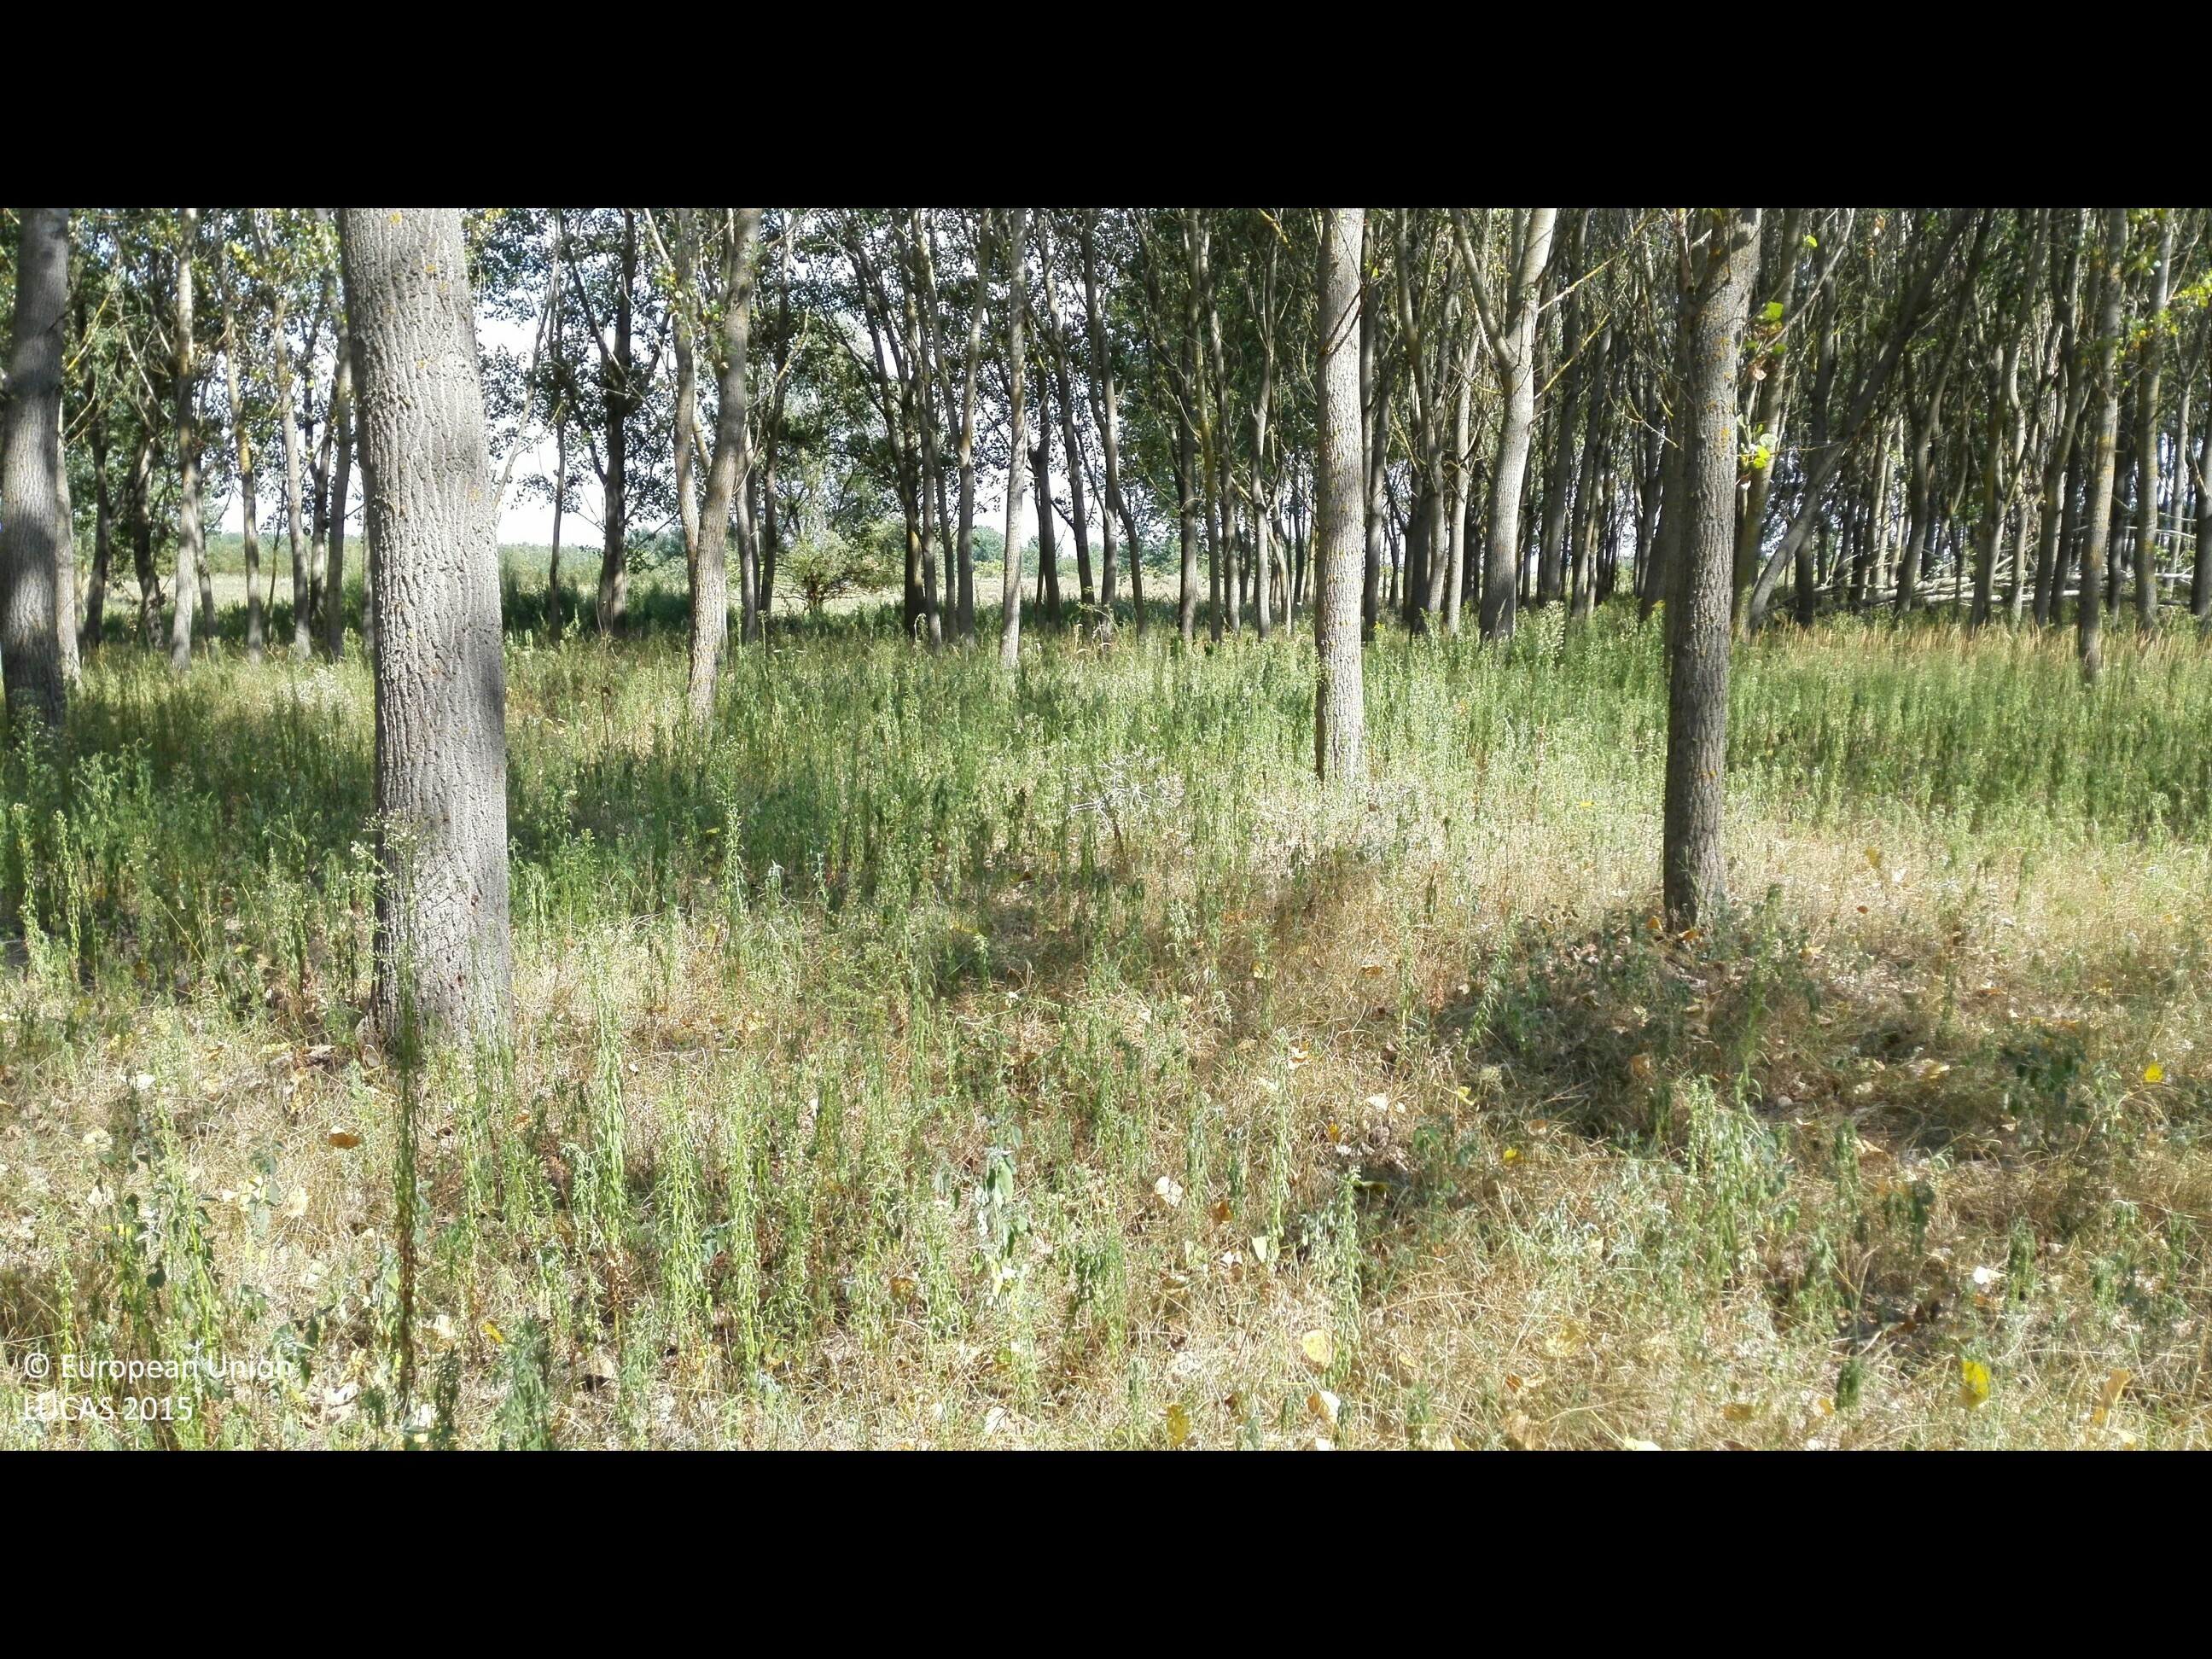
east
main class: Woodland
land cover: Broadleaved woodland
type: non-riverine alder, birch or aspen forest
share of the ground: > 75 %
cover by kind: broadleaved forest trees 90 %, herbaceous plants 10 %
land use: Forestry
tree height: > 5 m
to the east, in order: Broadleaved woodland; Grassland without tree/shrub cover; Tracks
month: August
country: HU
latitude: 47.3939
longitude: 21.9052
